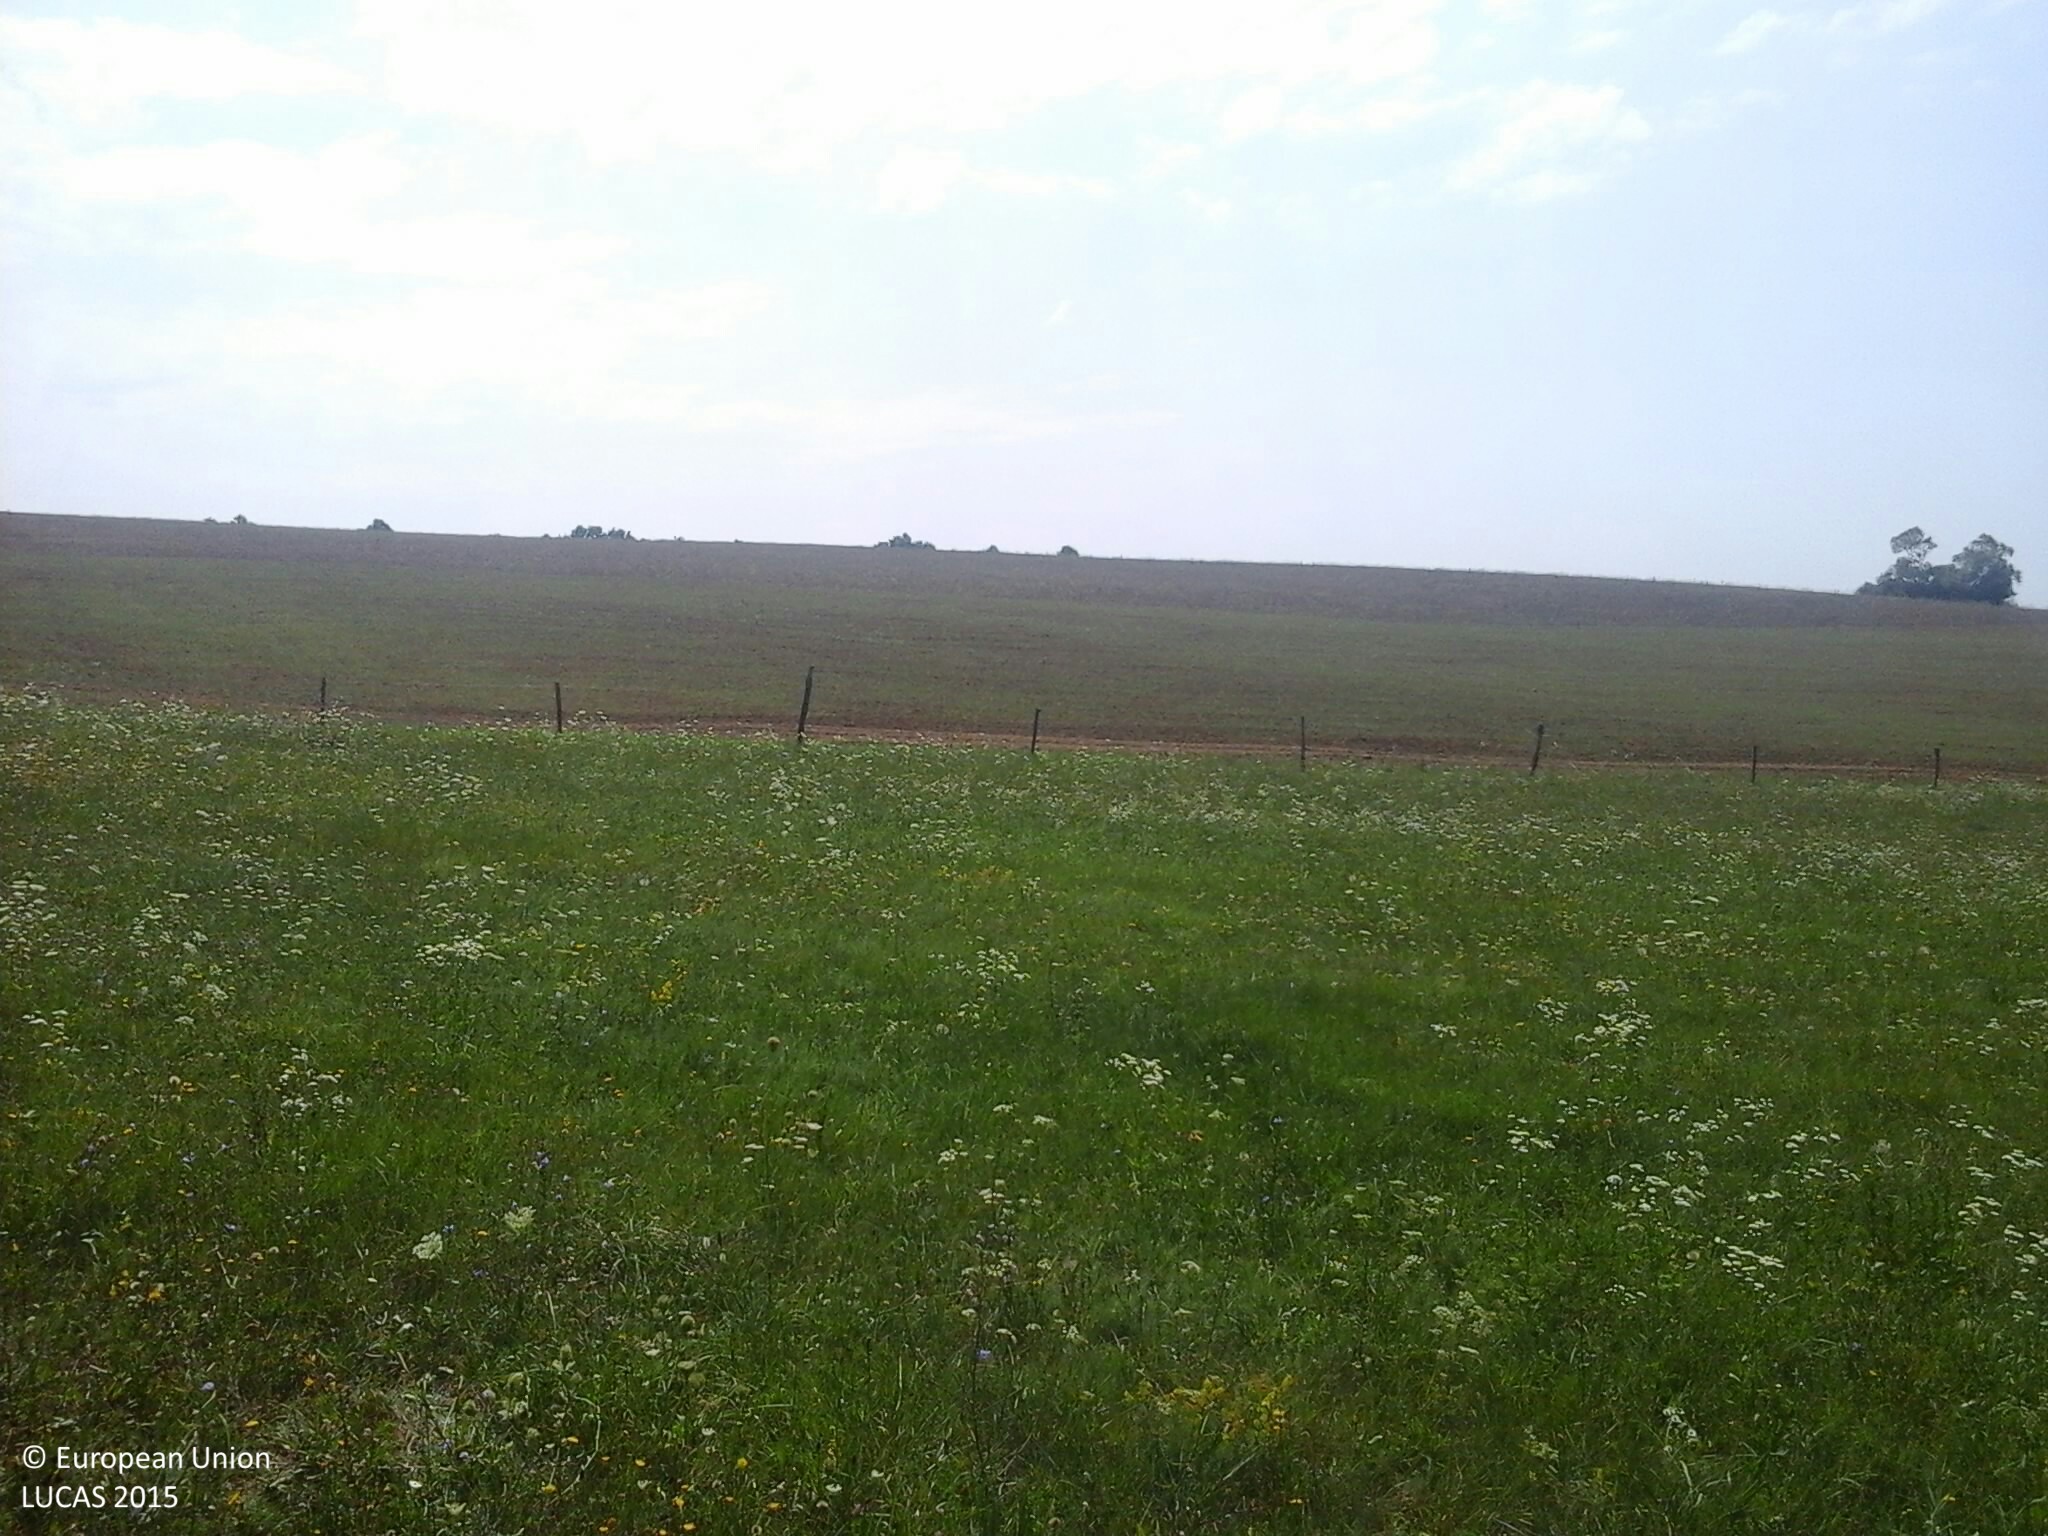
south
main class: Grassland
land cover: Grassland without tree/shrub cover
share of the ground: > 75 %
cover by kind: herbaceous plants 100 %
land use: Agriculture (excluding fallow land and kitchen gardens)
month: August
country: HU
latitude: 48.4878
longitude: 20.8223
